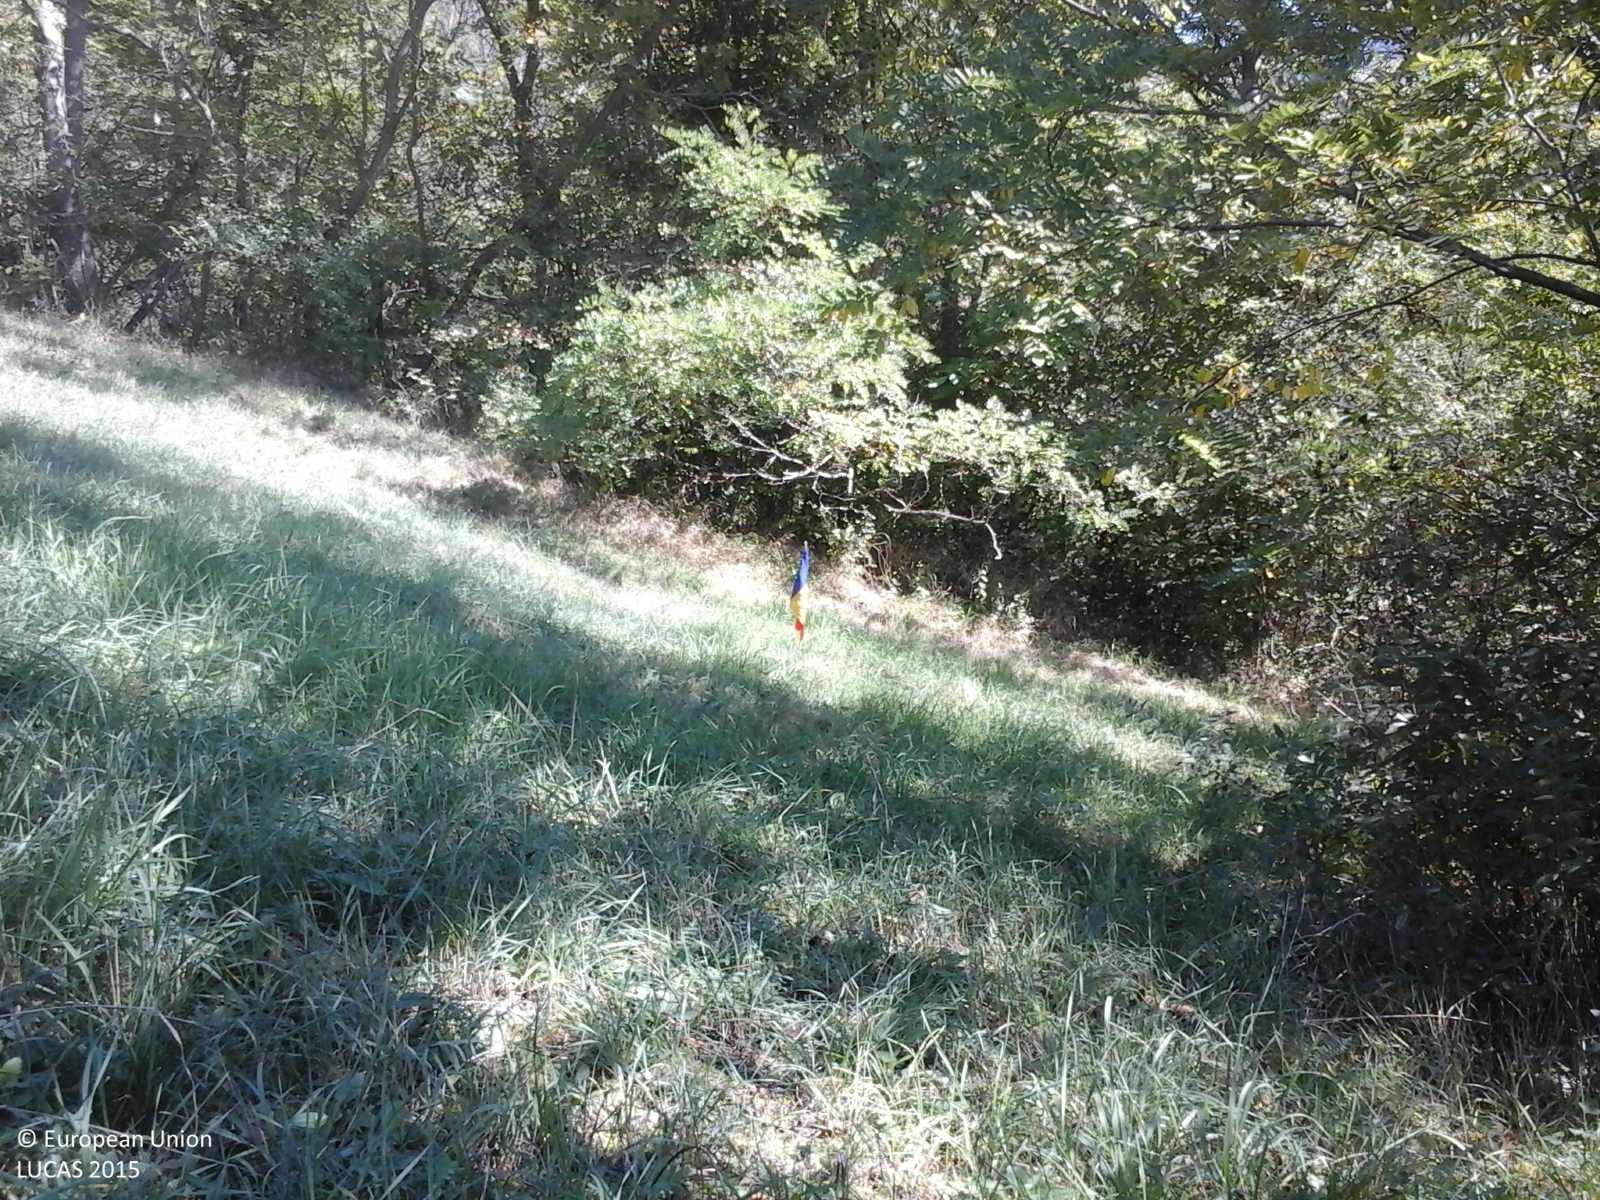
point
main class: Grassland
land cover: Grassland without tree/shrub cover
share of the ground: > 75 %
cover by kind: herbaceous plants 100 %
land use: Agriculture (excluding fallow land and kitchen gardens)
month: October
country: RO
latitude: 46.4446
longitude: 23.4612
